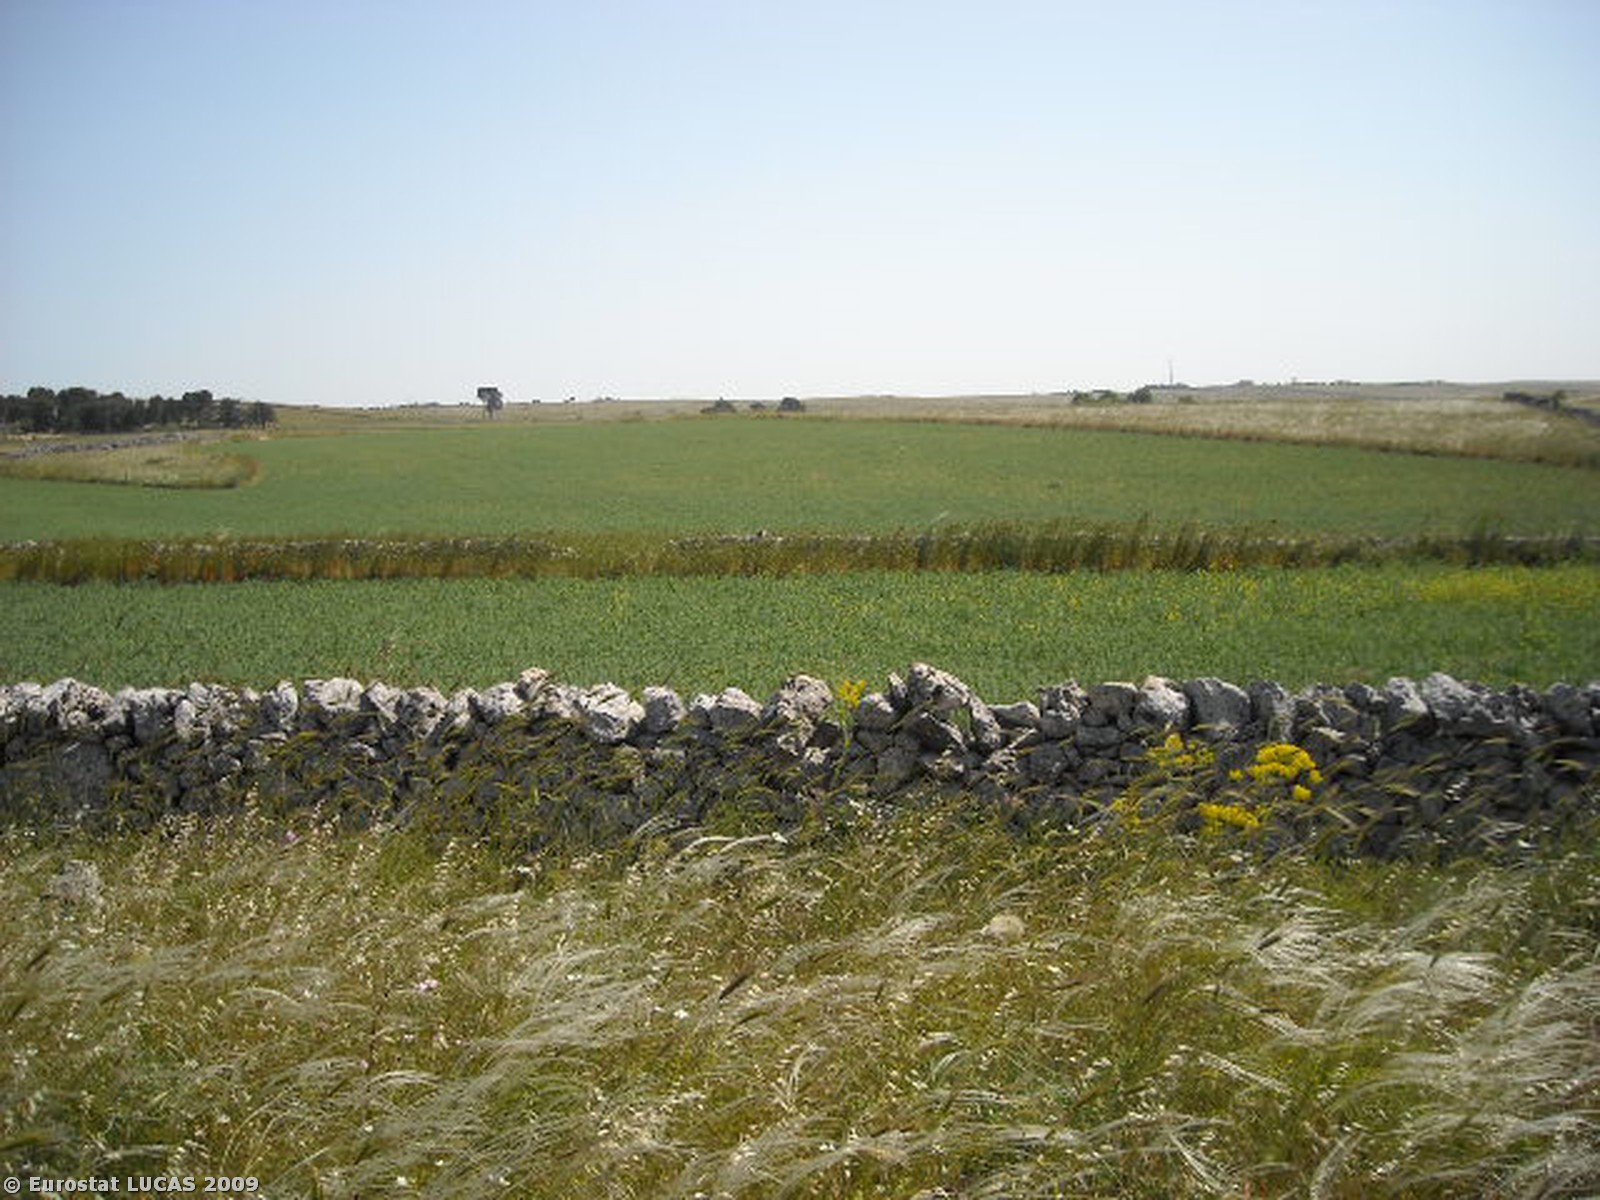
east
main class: Grassland
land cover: Grassland without tree/shrub cover
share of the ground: > 75 %
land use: Fallow land
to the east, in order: Grassland without tree/shrub cover; Dry stone walls; Grass margins; Dry pulses; Grass margins; Dry stone walls; Grass margins; Dry pulses; Grassland without tree/shrub cover; Dry stone walls; Grassland without tree/shrub cover; Dry stone walls; Grassland without tree/shrub cover; Dry stone walls; Grassland without tree/shrub cover; Dry stone walls; Grassland without tree/shrub cover; Dry stone walls; Grass margins; Durum wheat; Grass margins; Dry stone walls; Grassland without tree/shrub cover
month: May
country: IT
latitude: 40.8609
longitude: 16.6097
